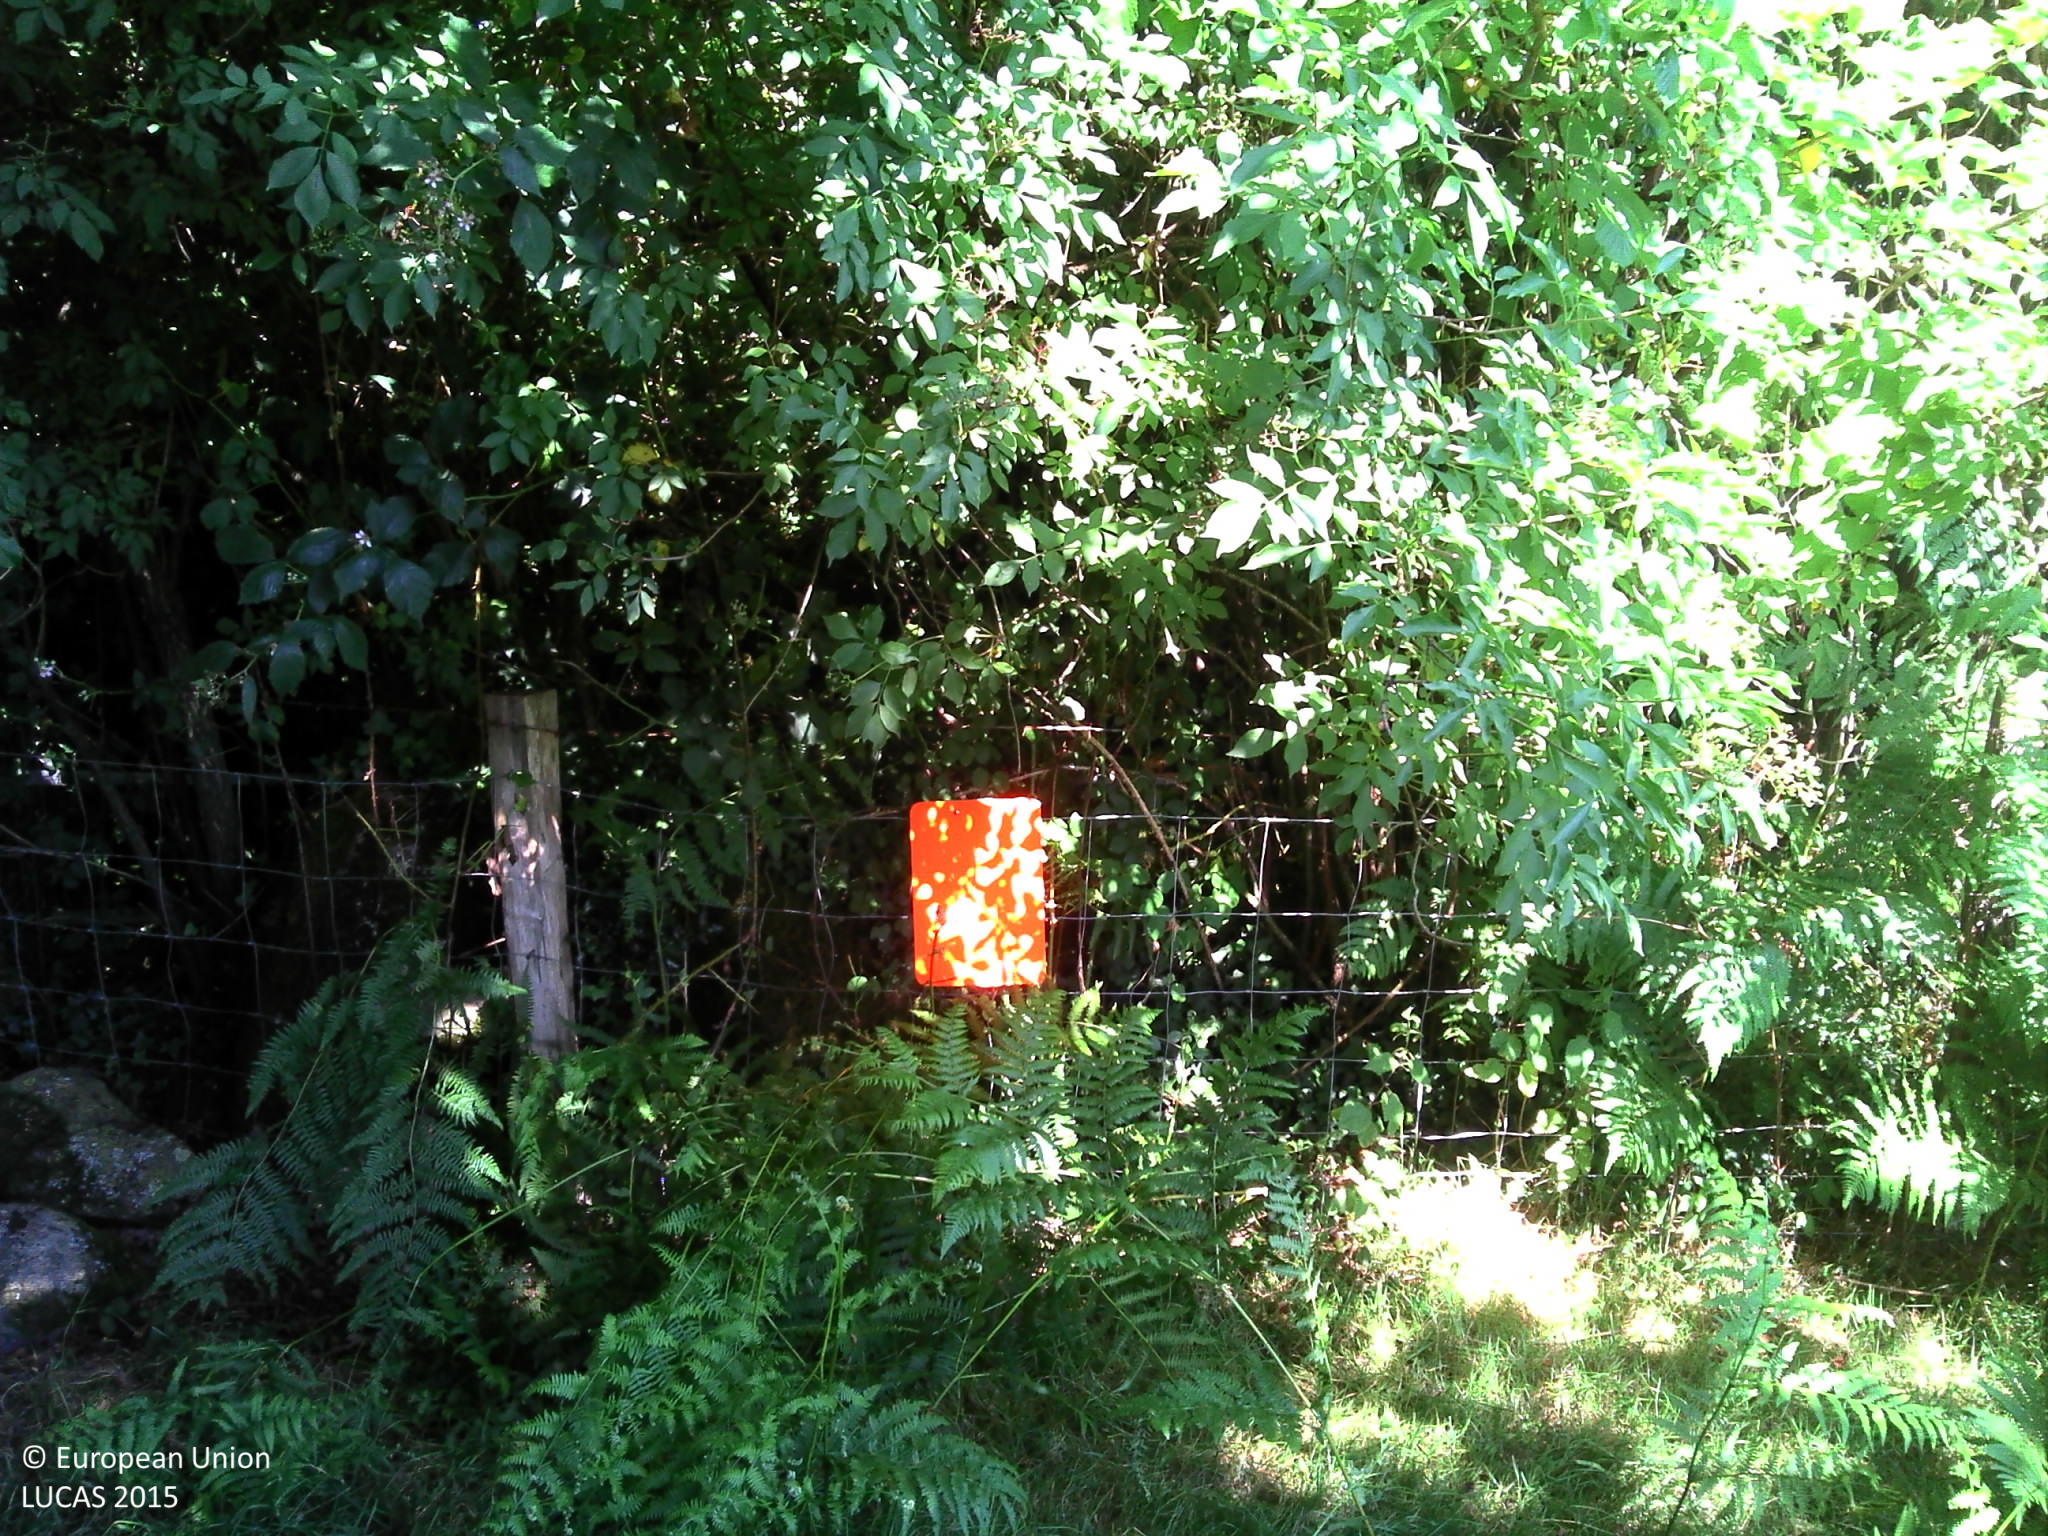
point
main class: Woodland
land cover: Broadleaved woodland
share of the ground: > 75 %
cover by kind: broadleaved forest trees 90 %, shrubs 10 %
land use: Semi-natural and natural areas not in use
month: June
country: FR
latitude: 45.7408
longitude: 0.6432
